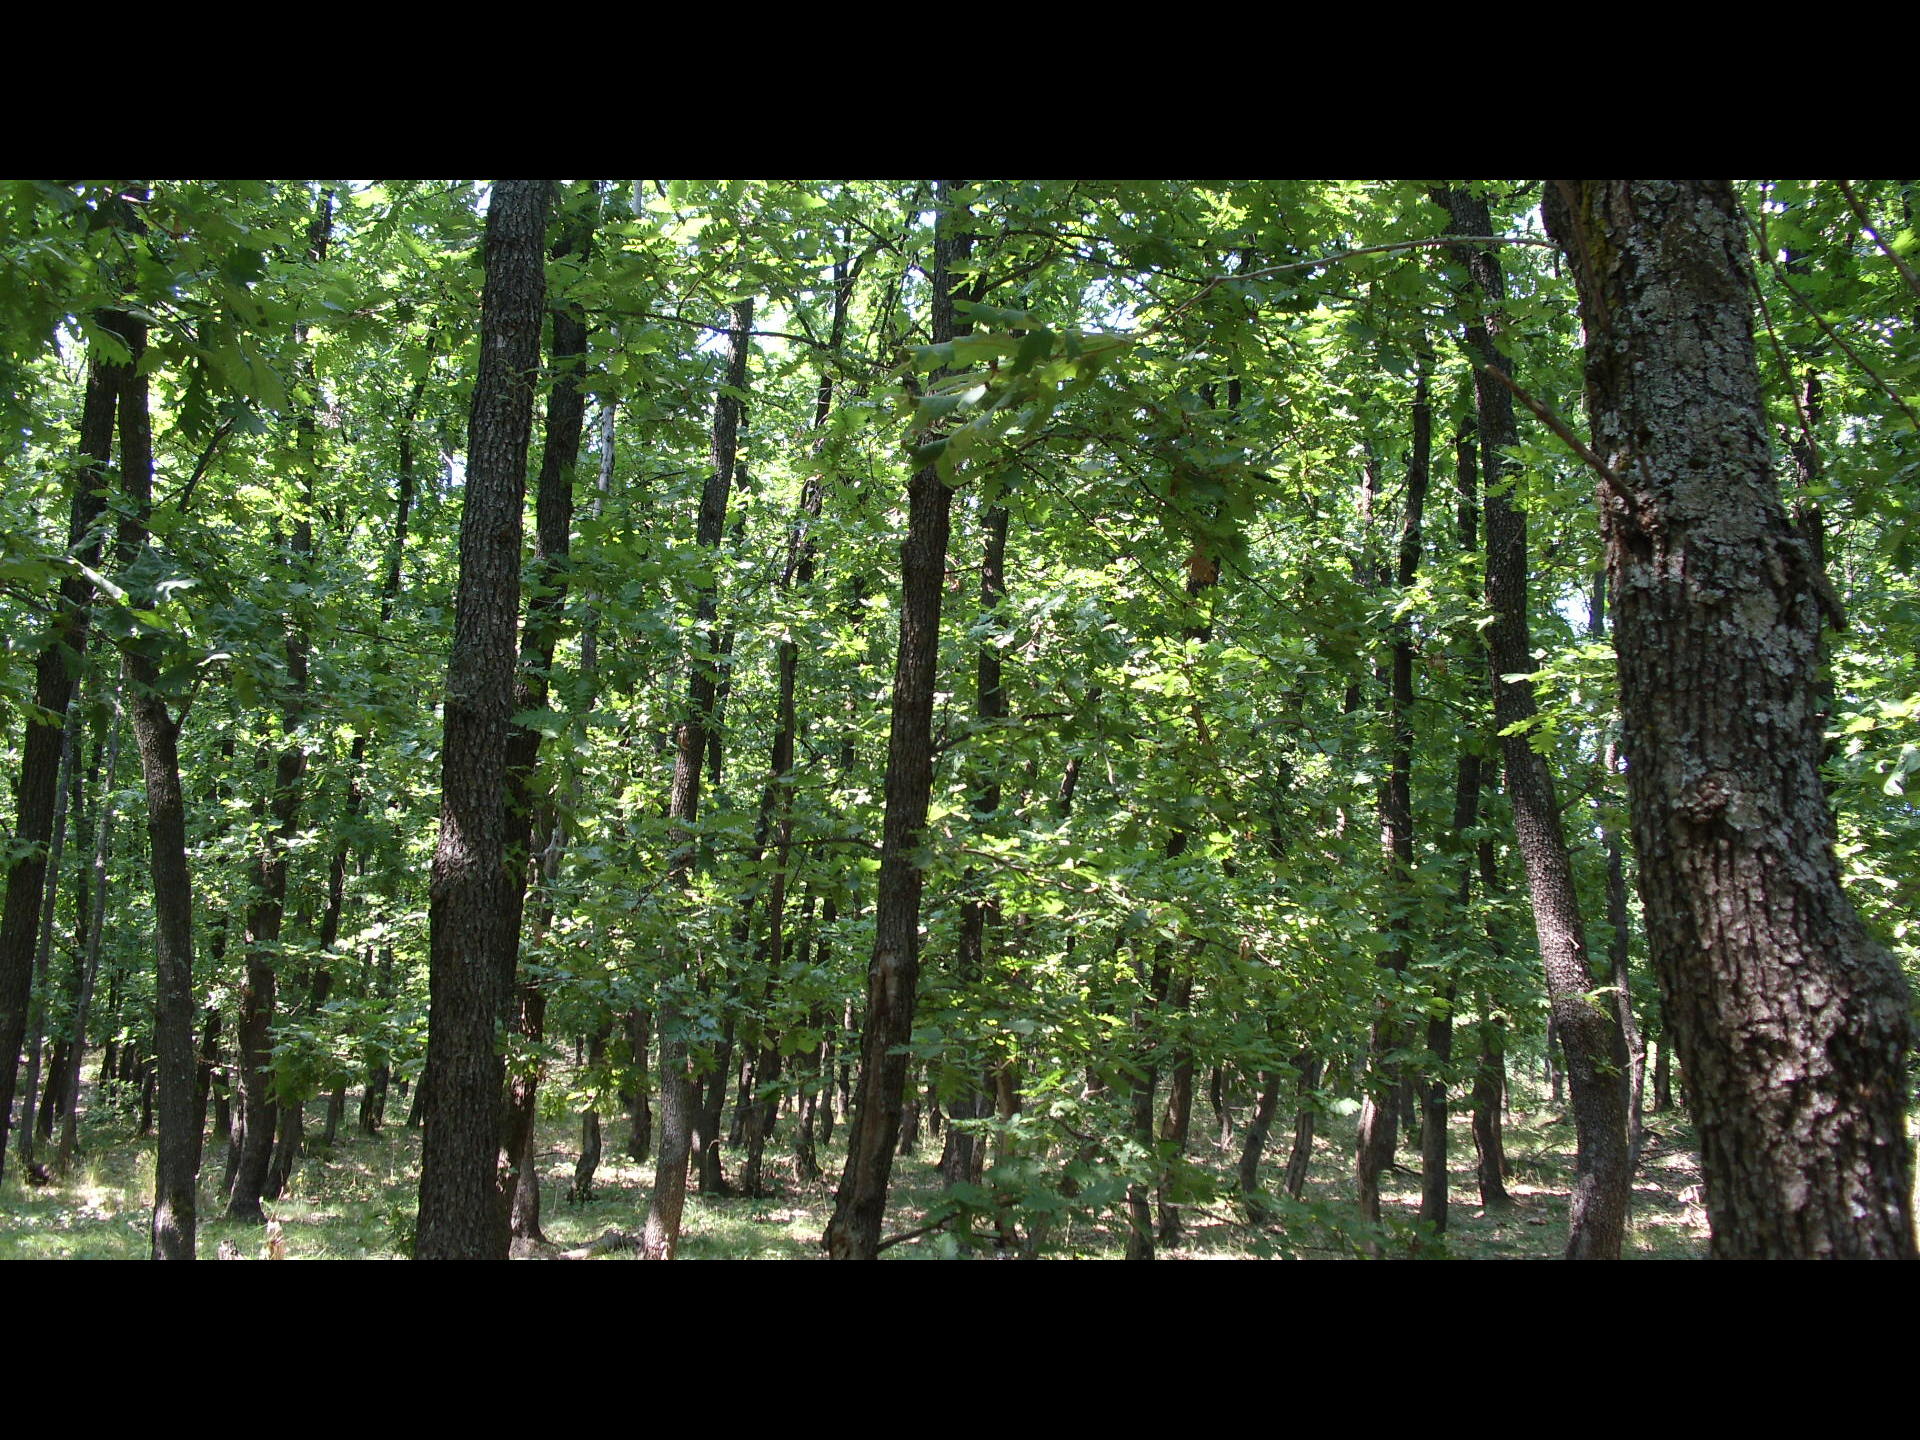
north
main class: Woodland
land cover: Broadleaved woodland
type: mesophytic deciduous forest
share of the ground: > 75 %
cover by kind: broadleaved forest trees 80 %, shrubs 10 %, herbaceous plants 10 %
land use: Forestry
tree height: > 5 m
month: July
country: BG
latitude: 43.7685
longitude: 22.5428
